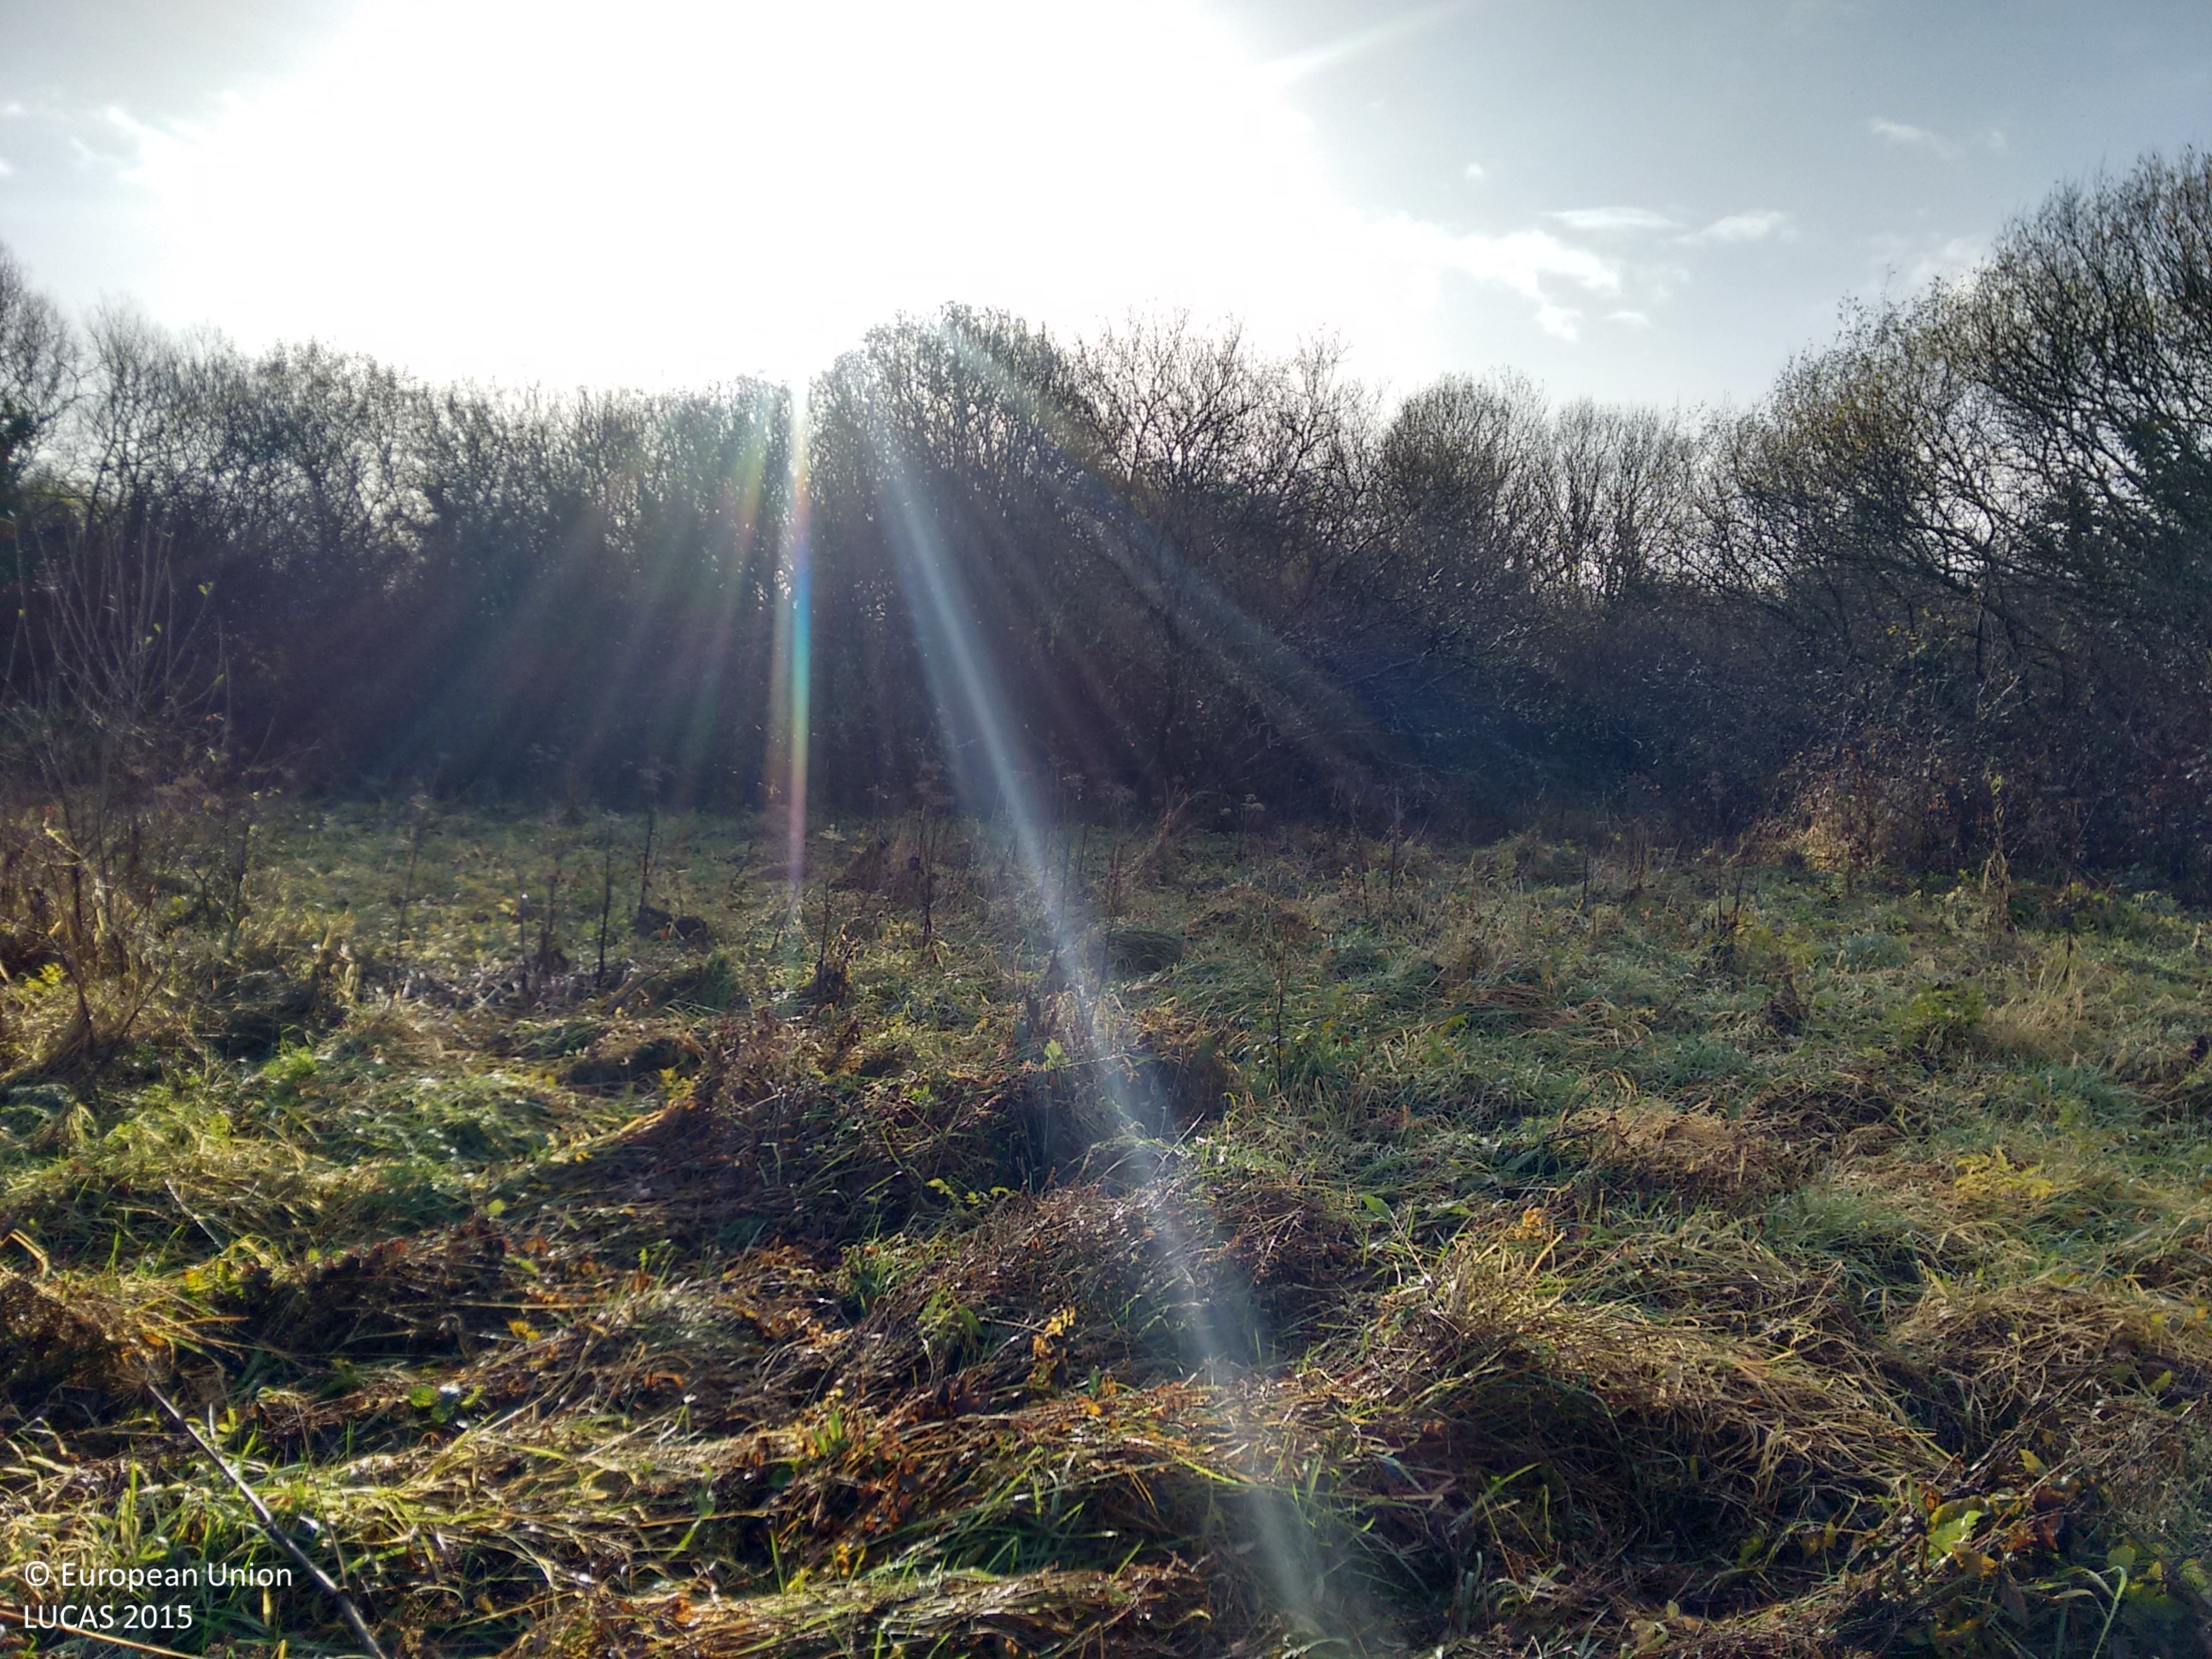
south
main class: Grassland
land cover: Spontaneously vegetated surfaces
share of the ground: > 75 %
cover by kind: herbaceous plants 95 %, shrubs 5 %
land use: Semi-natural and natural areas not in use
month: November
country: IE
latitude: 53.9793
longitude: -7.9676
